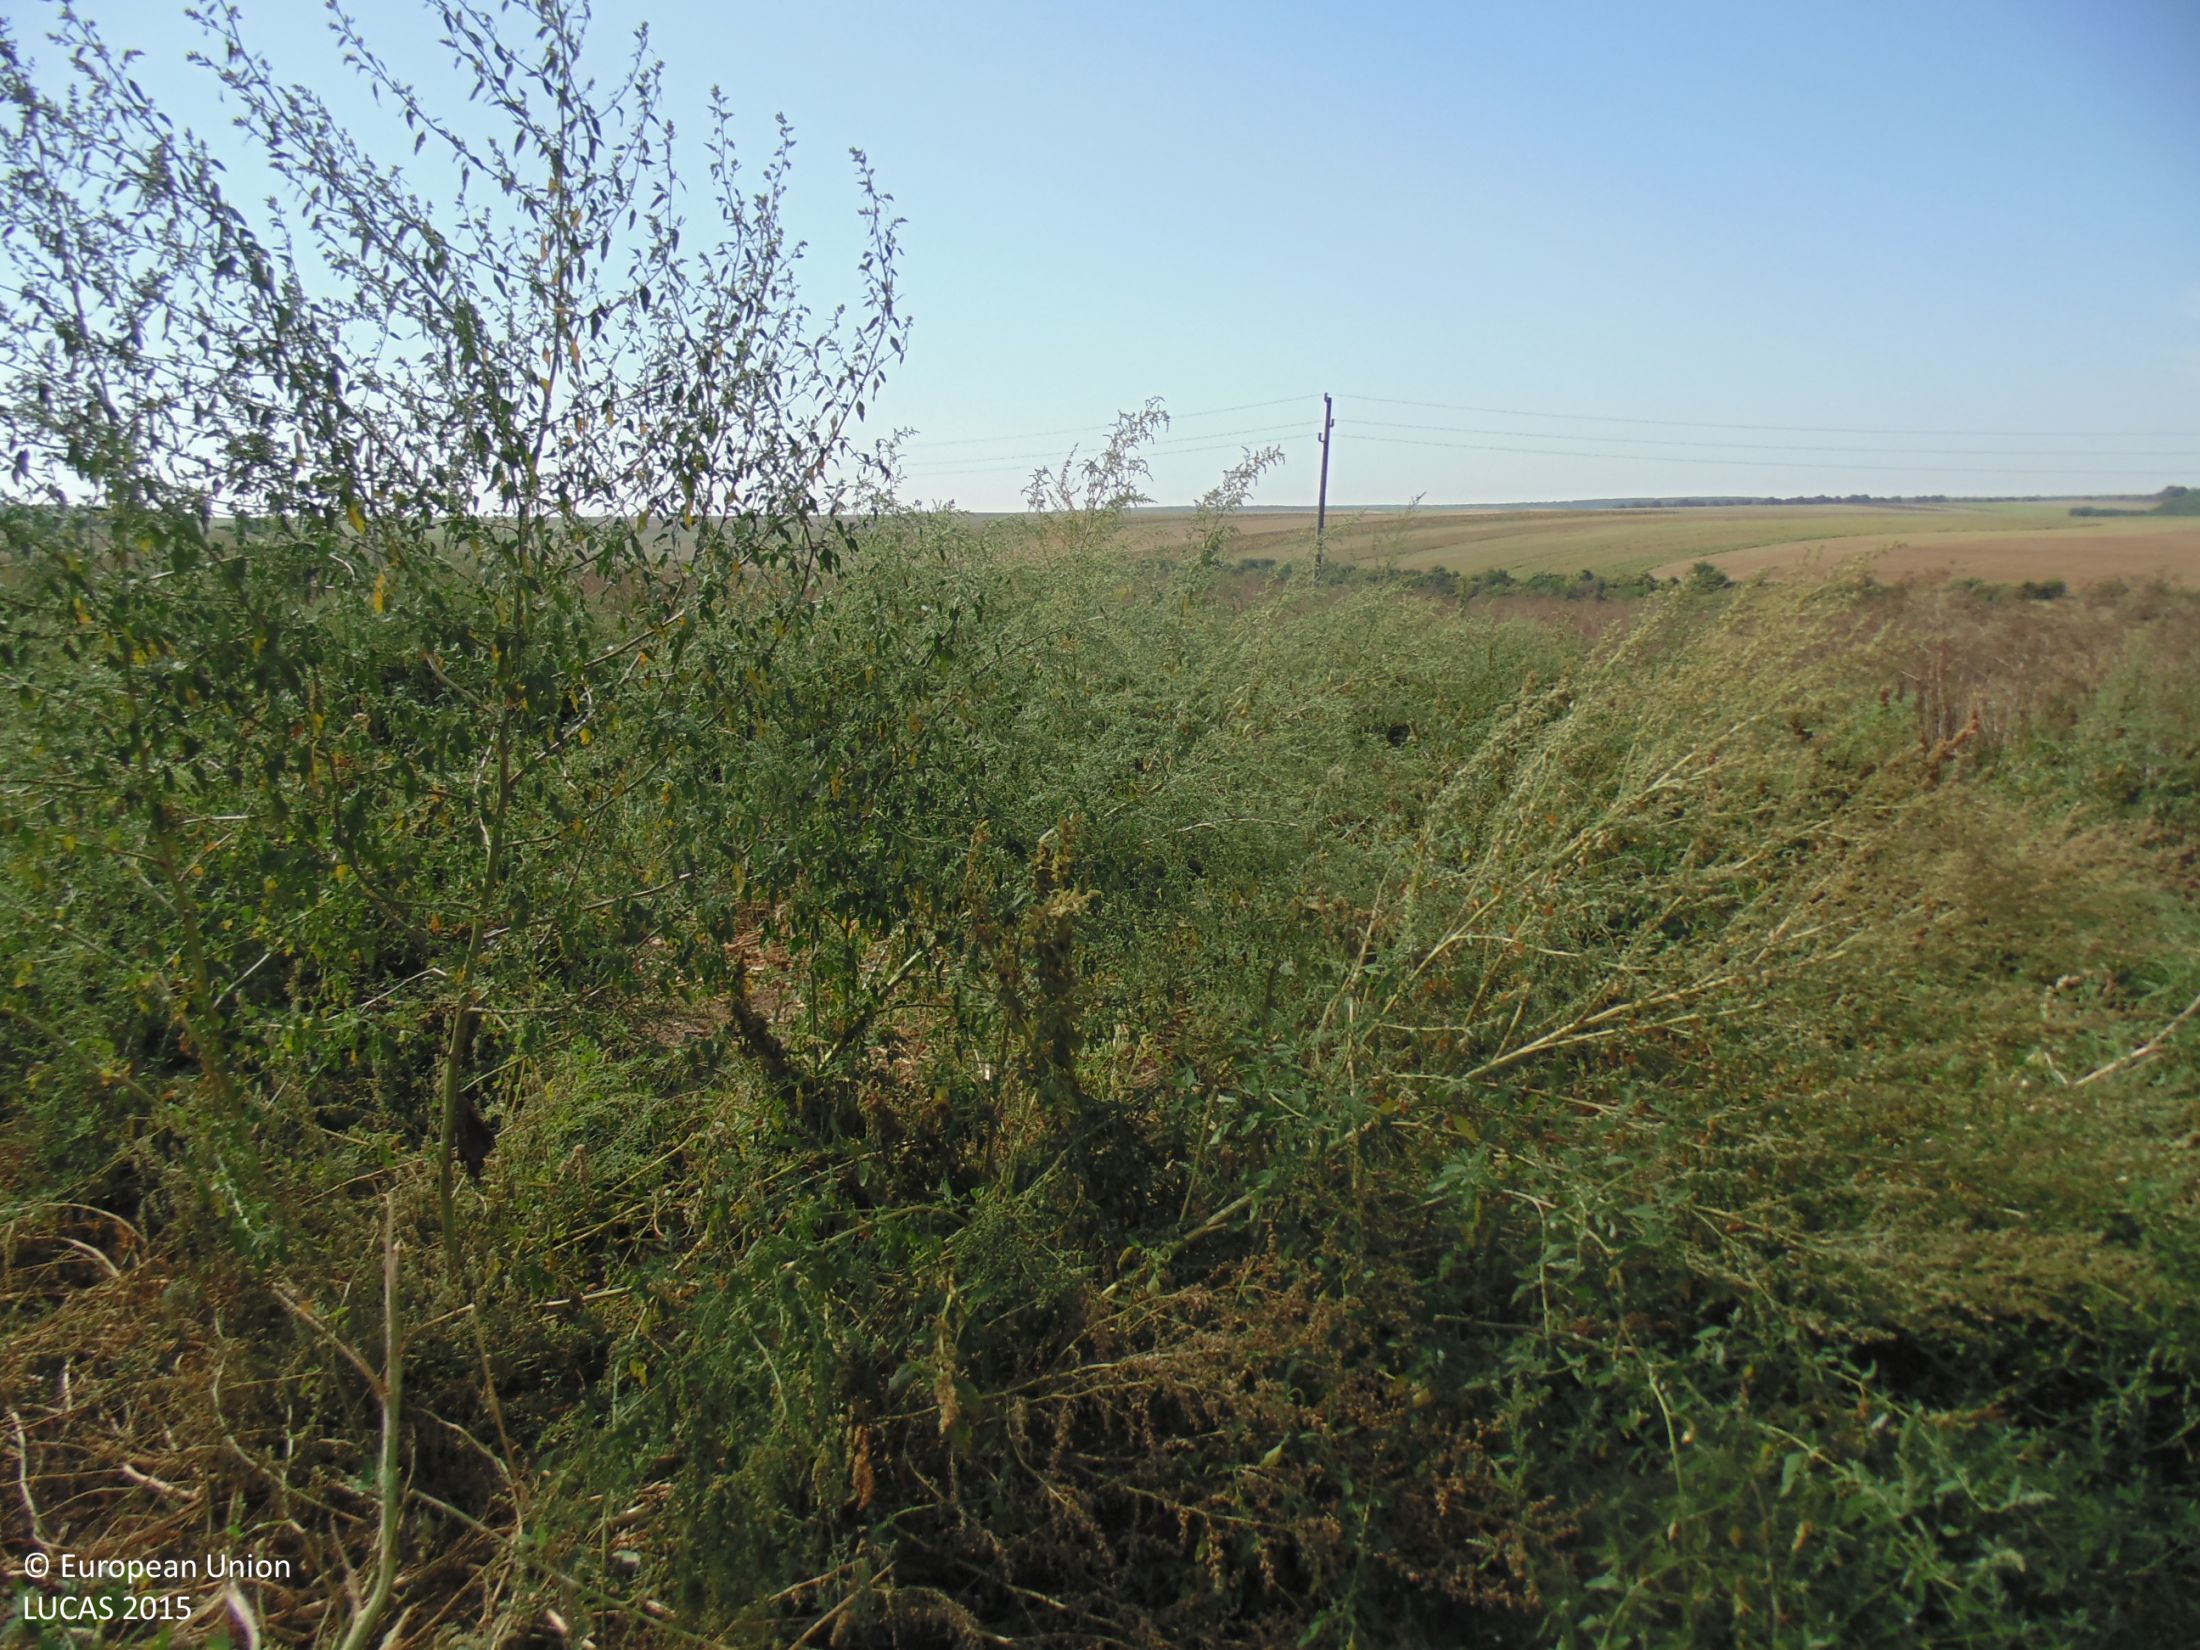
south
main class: Cropland
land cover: Other fresh vegetables
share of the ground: > 75 %
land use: Agriculture (excluding fallow land and kitchen gardens)
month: September
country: BG
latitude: 43.8775
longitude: 27.0872
